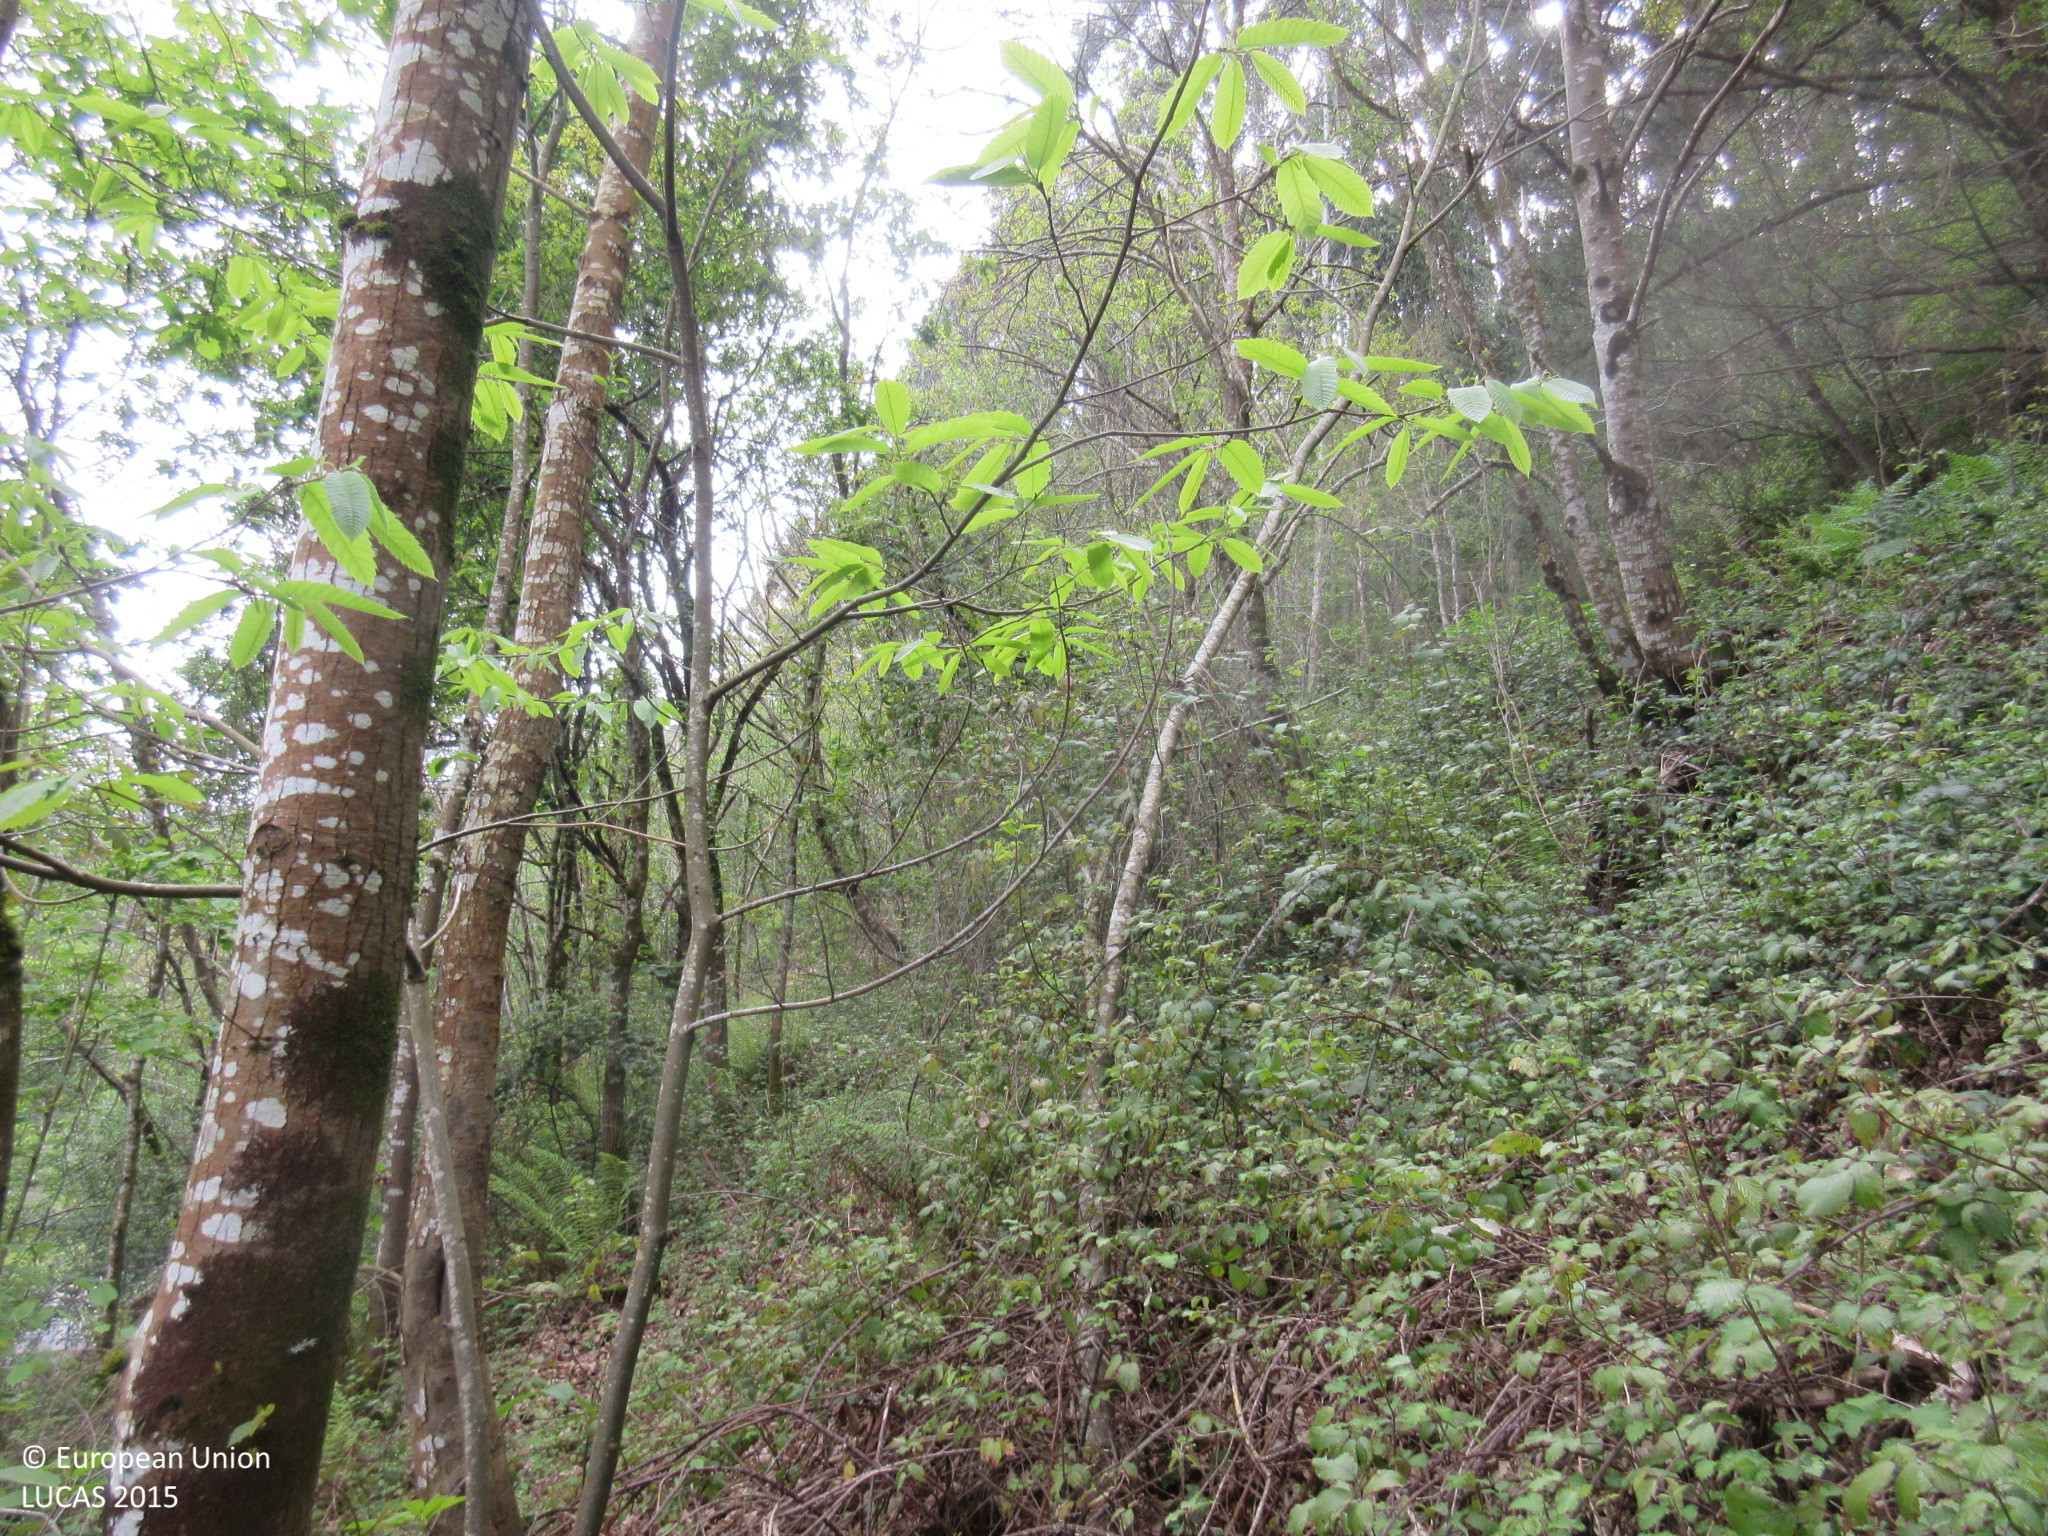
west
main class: Woodland
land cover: Broadleaved woodland
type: acidophilous oak and oak-birch forest
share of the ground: > 75 %
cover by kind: broadleaved forest trees 100 %
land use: Forestry
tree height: > 5 m
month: April
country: ES
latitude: 43.5059
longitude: -6.4423
